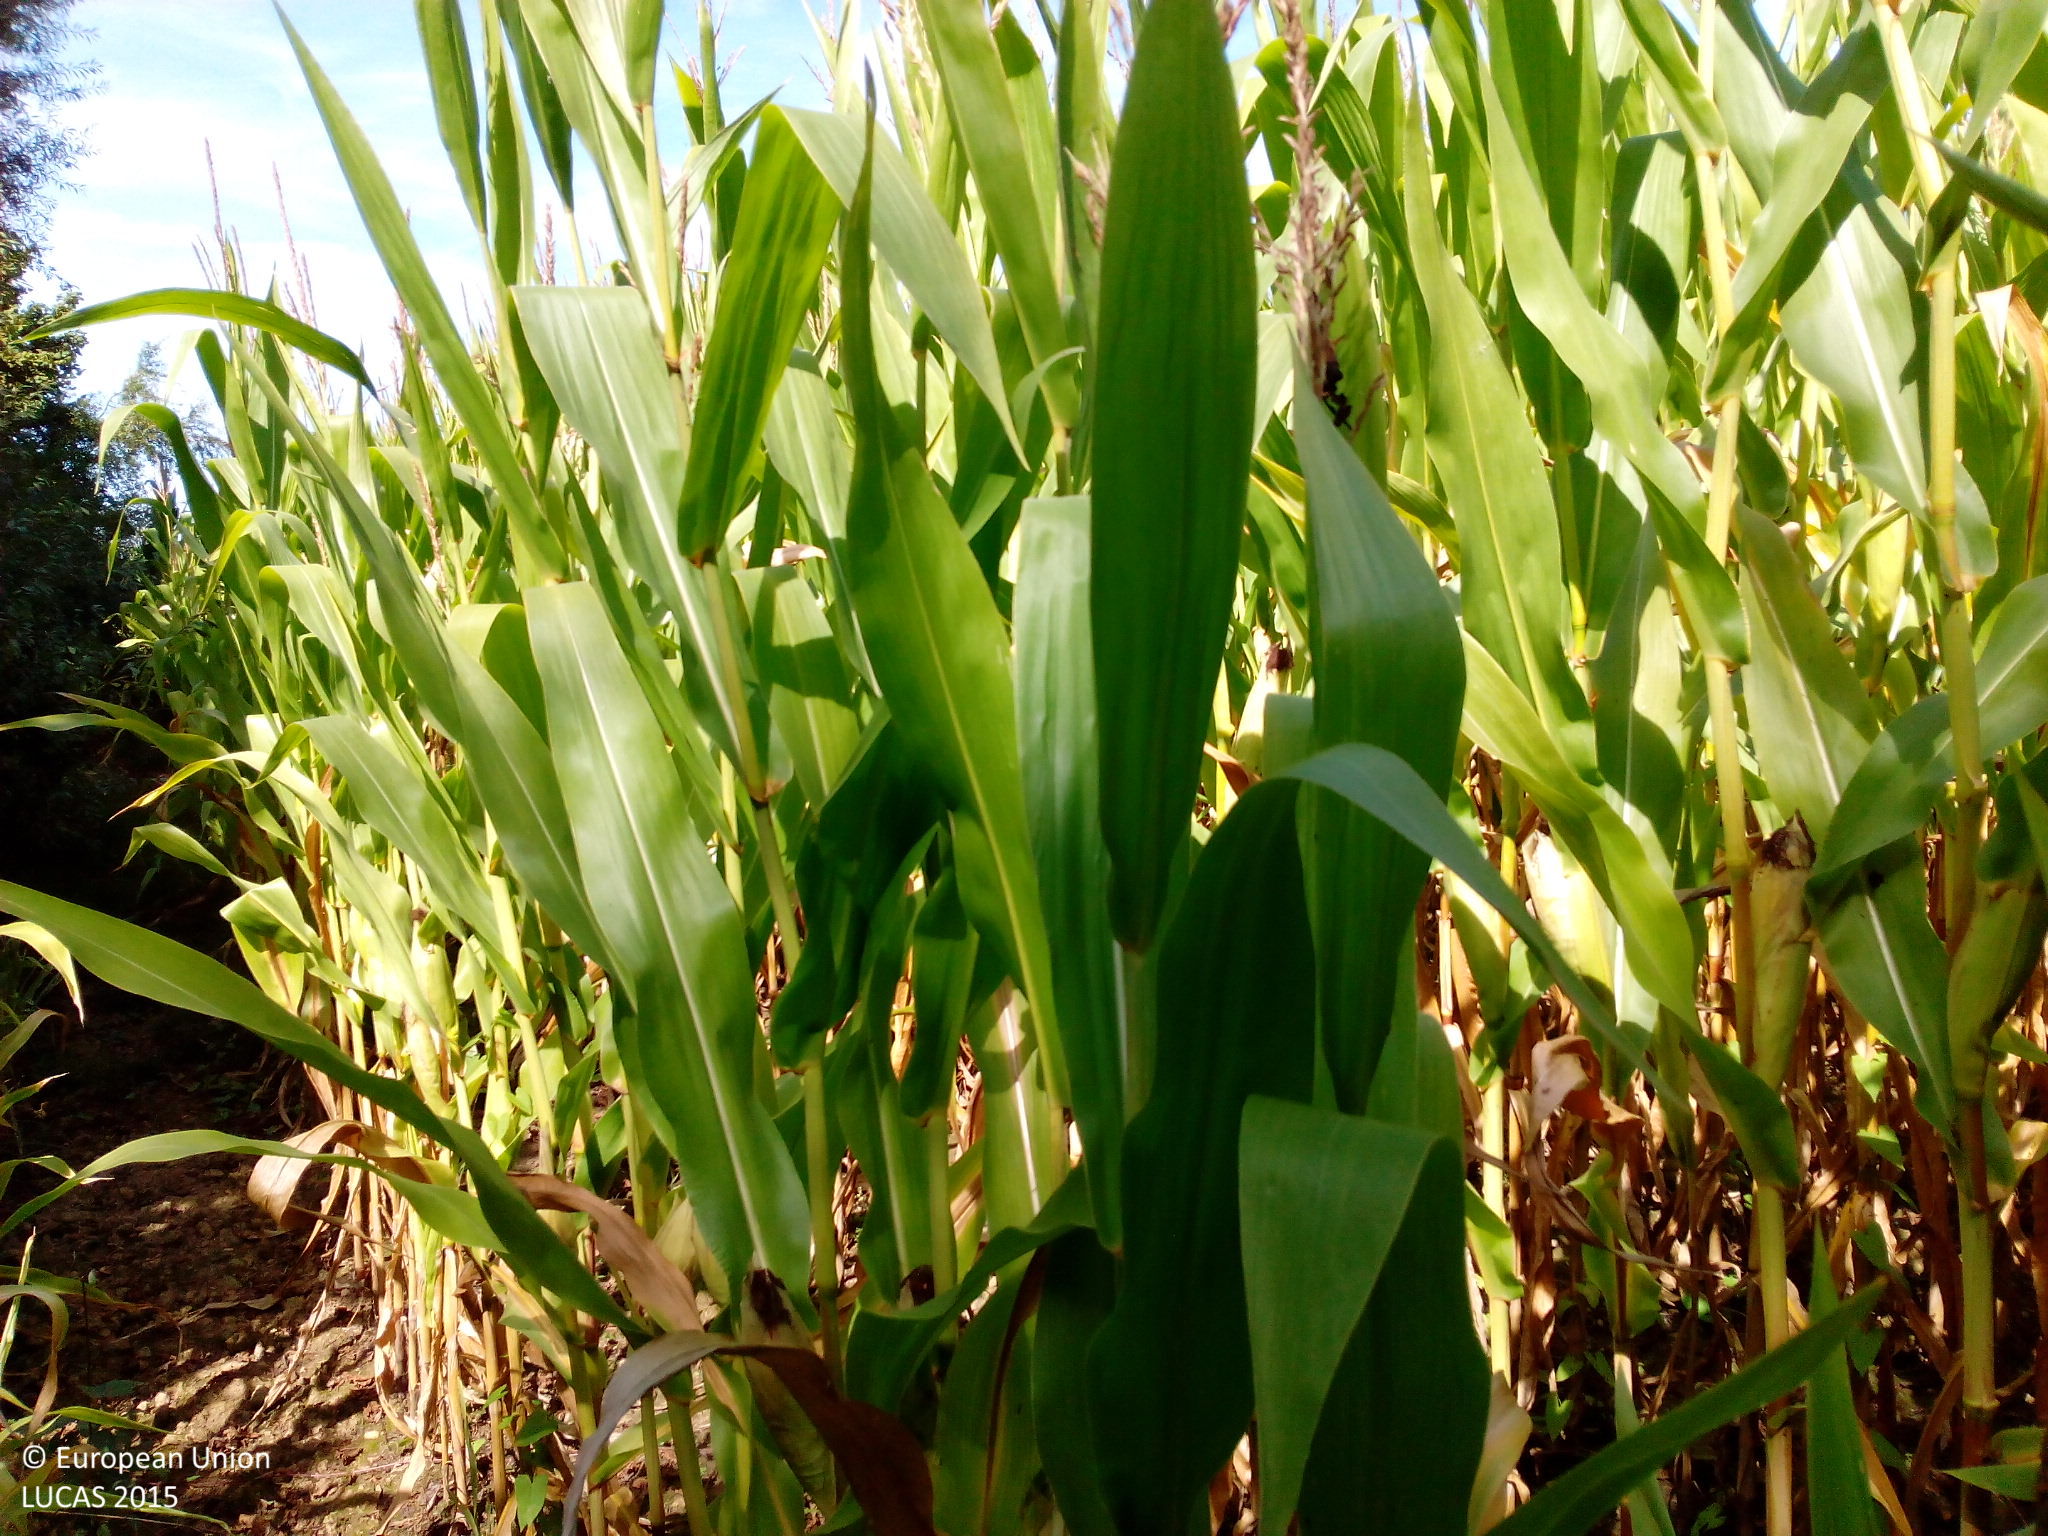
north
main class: Cropland
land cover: Maize
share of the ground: > 75 %
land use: Agriculture (excluding fallow land and kitchen gardens)
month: August
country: DE
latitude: 48.2775
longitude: 9.9327
